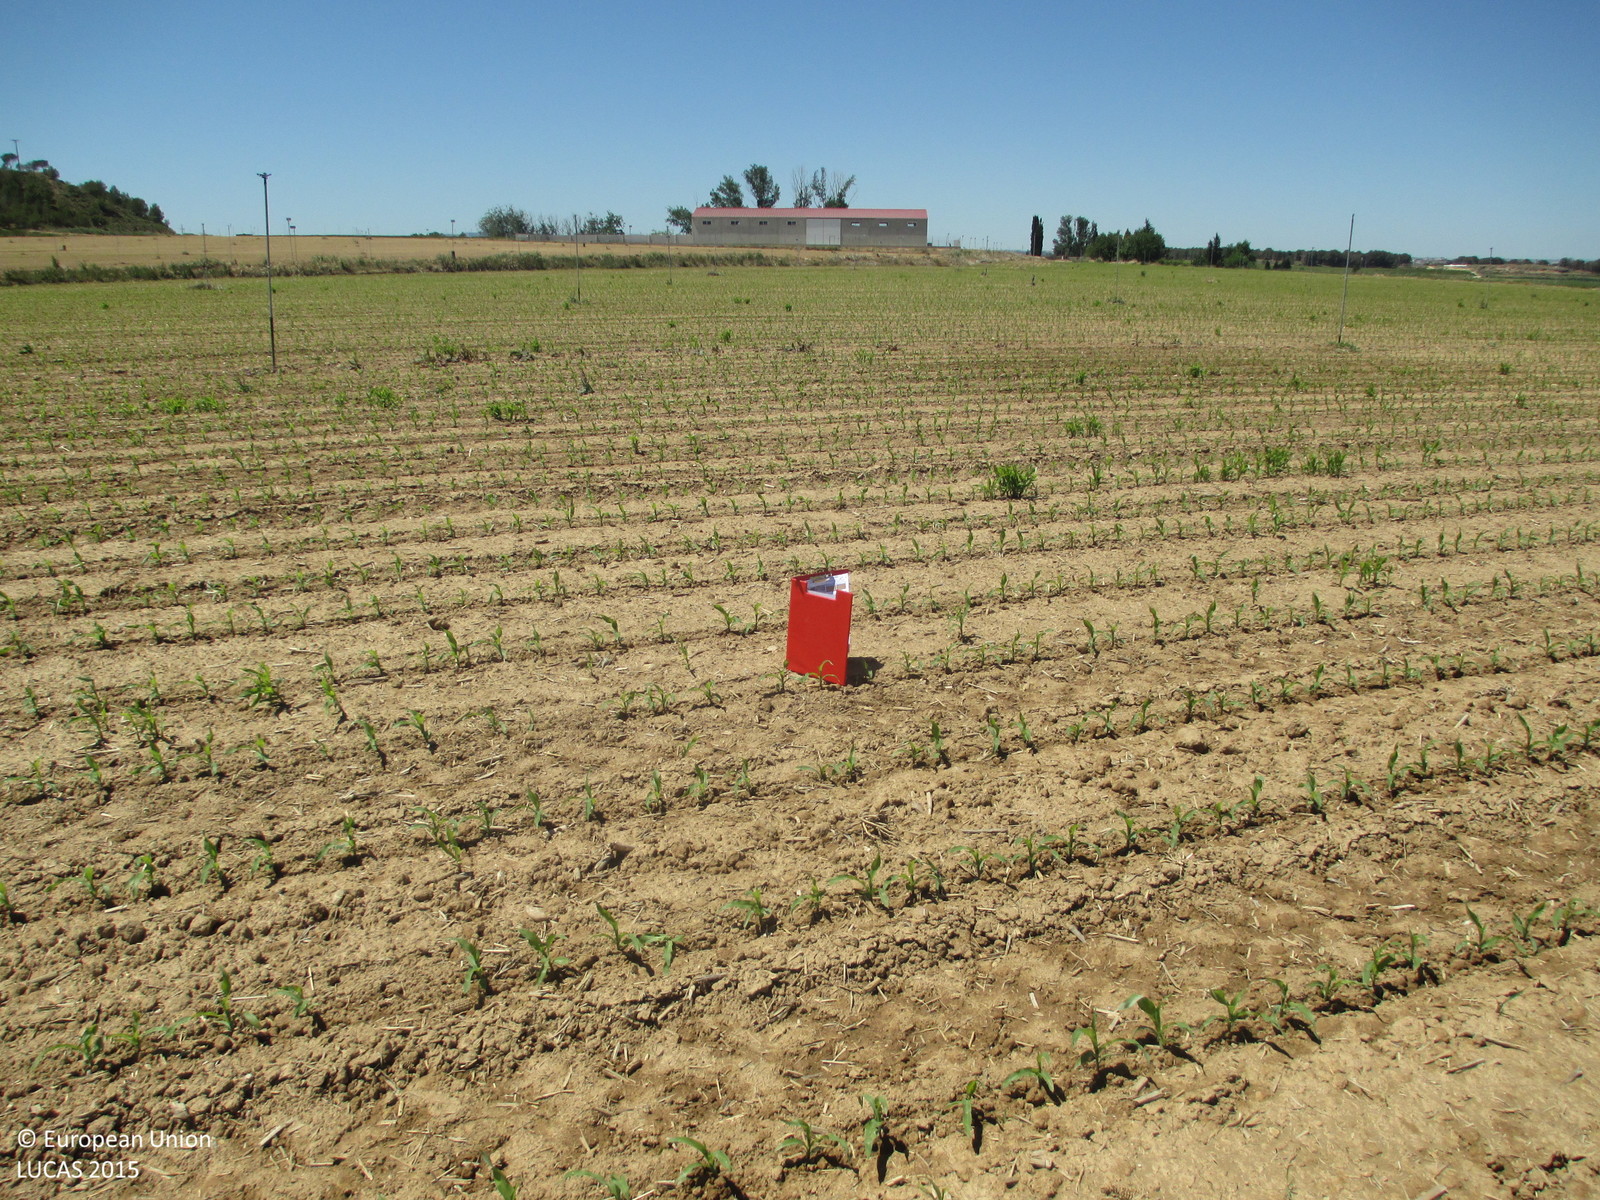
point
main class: Cropland
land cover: Maize
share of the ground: < 10 %
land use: Agriculture (excluding fallow land and kitchen gardens)
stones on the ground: < 10 %
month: May
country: ES
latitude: 41.9089
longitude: -0.3033
